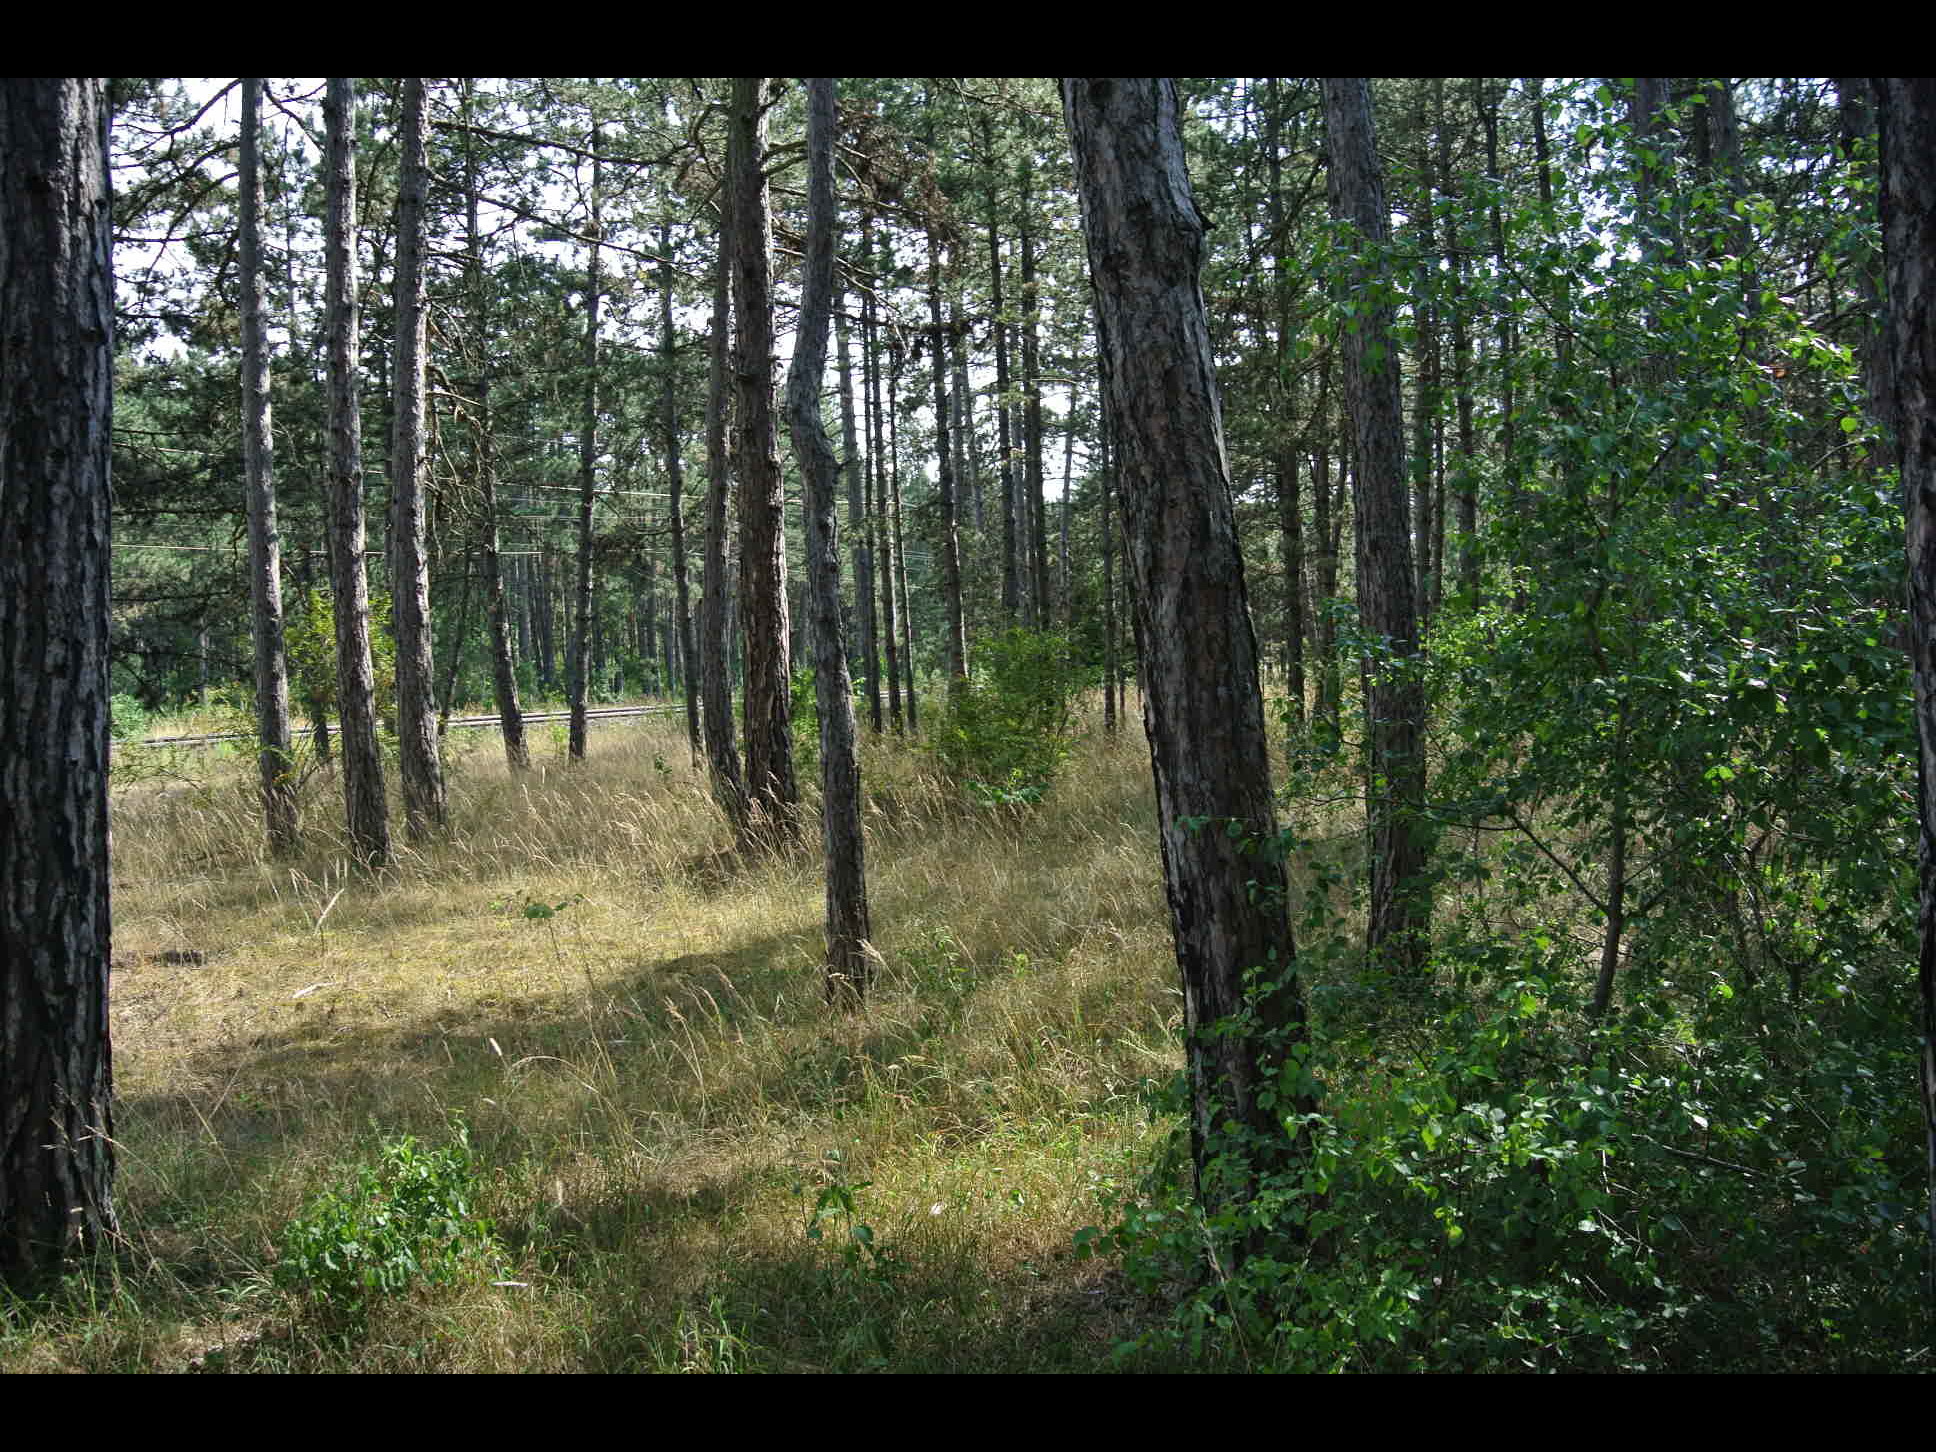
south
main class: Woodland
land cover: Pine dominated coniferous woodland
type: alpine coniferous forest
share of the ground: > 75 %
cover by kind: coniferous forest trees 90 %, herbaceous plants 10 %
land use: Forestry
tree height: > 5 m
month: July
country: AT
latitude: 47.7793
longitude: 16.1826
